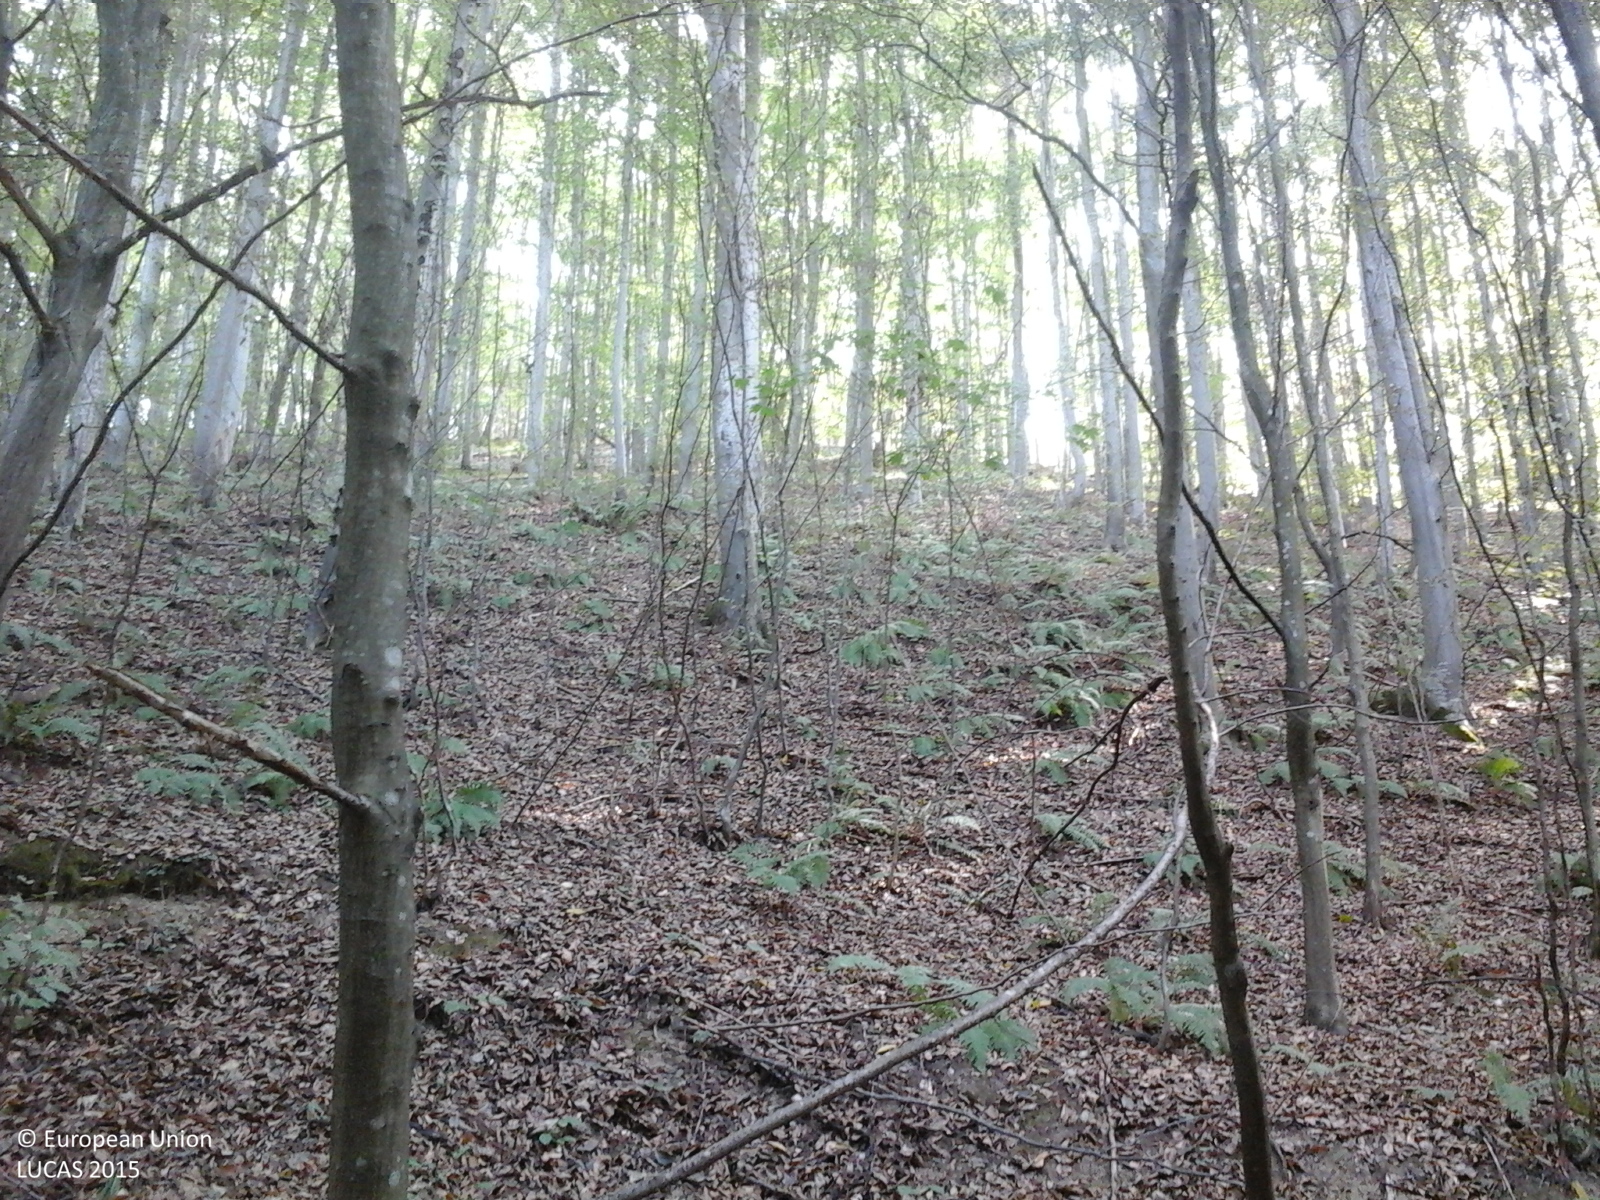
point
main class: Woodland
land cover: Broadleaved woodland
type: beech forest
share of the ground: > 75 %
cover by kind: broadleaved forest trees 100 %
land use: Forestry
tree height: > 5 m
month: September
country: RO
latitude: 45.3812
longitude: 22.0041
